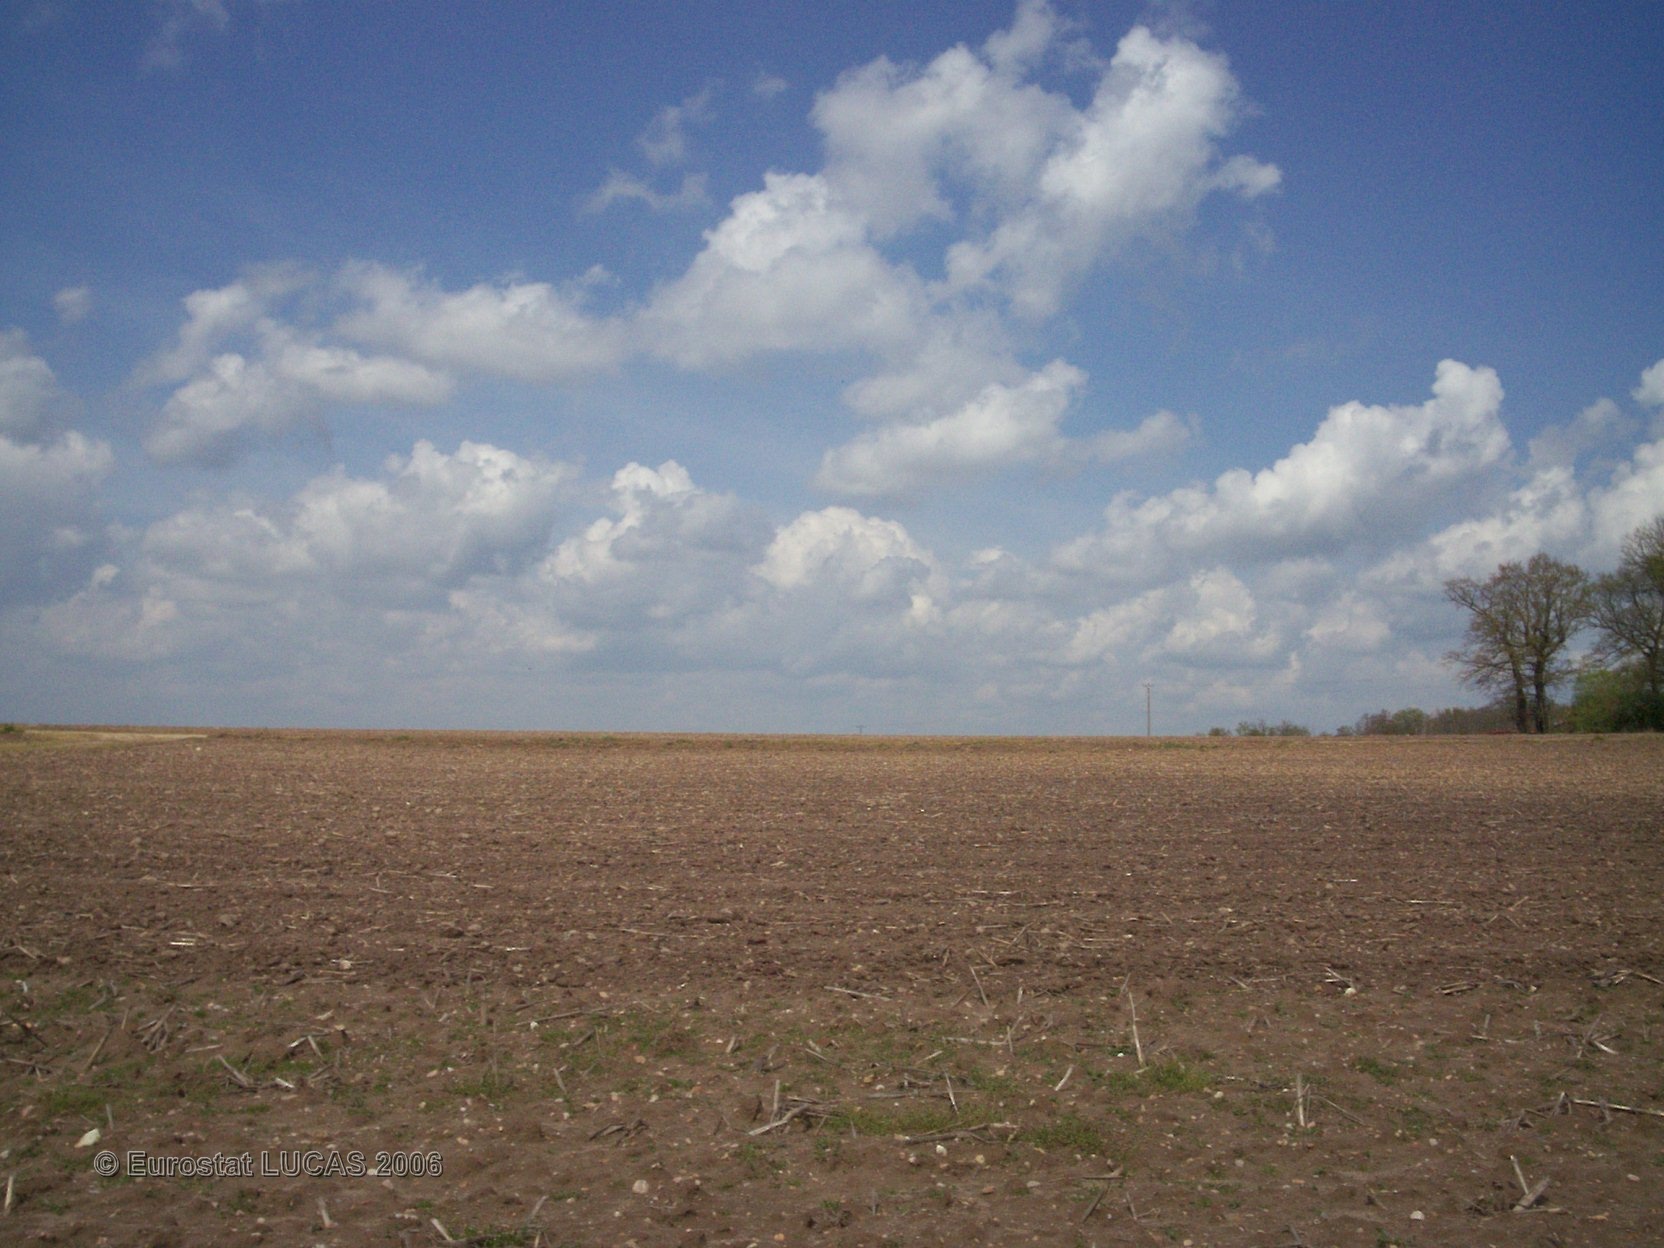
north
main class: Cropland
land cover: Maize
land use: Agriculture (excluding fallow land and kitchen gardens)
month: June
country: FR
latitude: 46.3098
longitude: 0.5174
